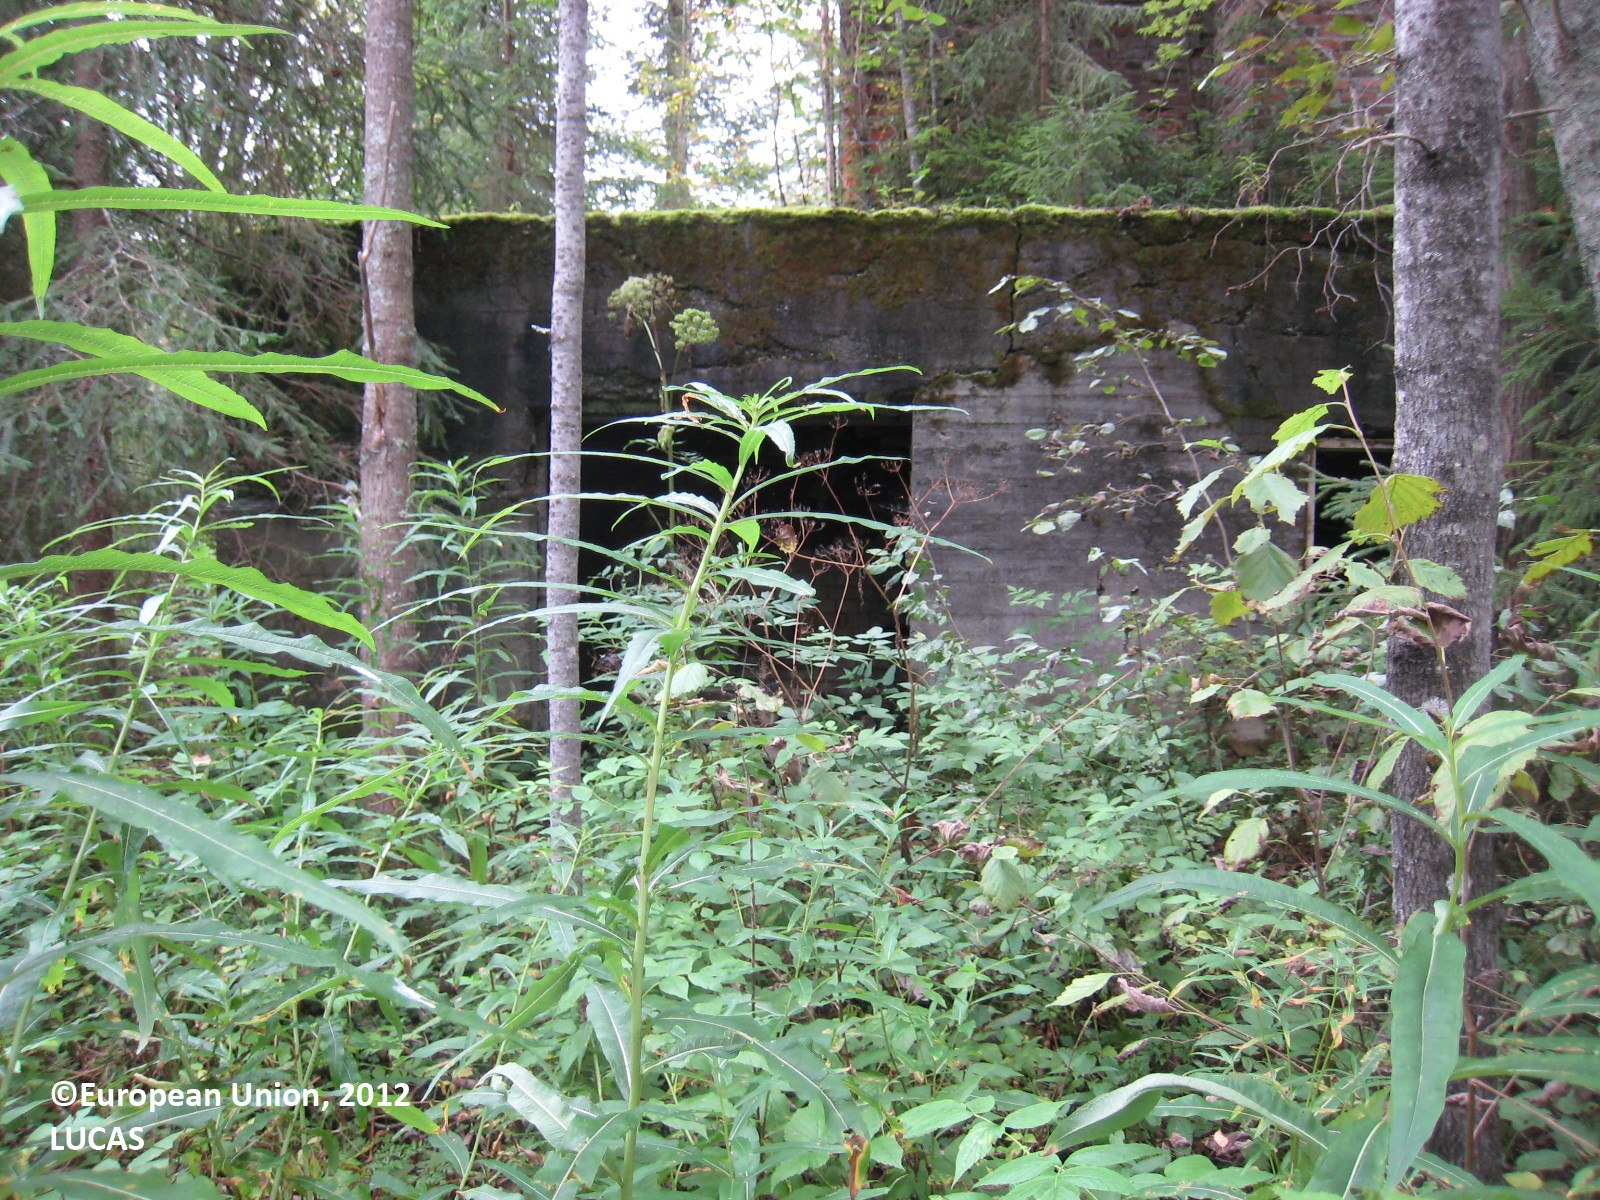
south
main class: Woodland
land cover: Spruce dominated mixed woodland
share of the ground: 50 - 75 %
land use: Forestry
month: August
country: FI
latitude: 62.3675
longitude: 27.3853
